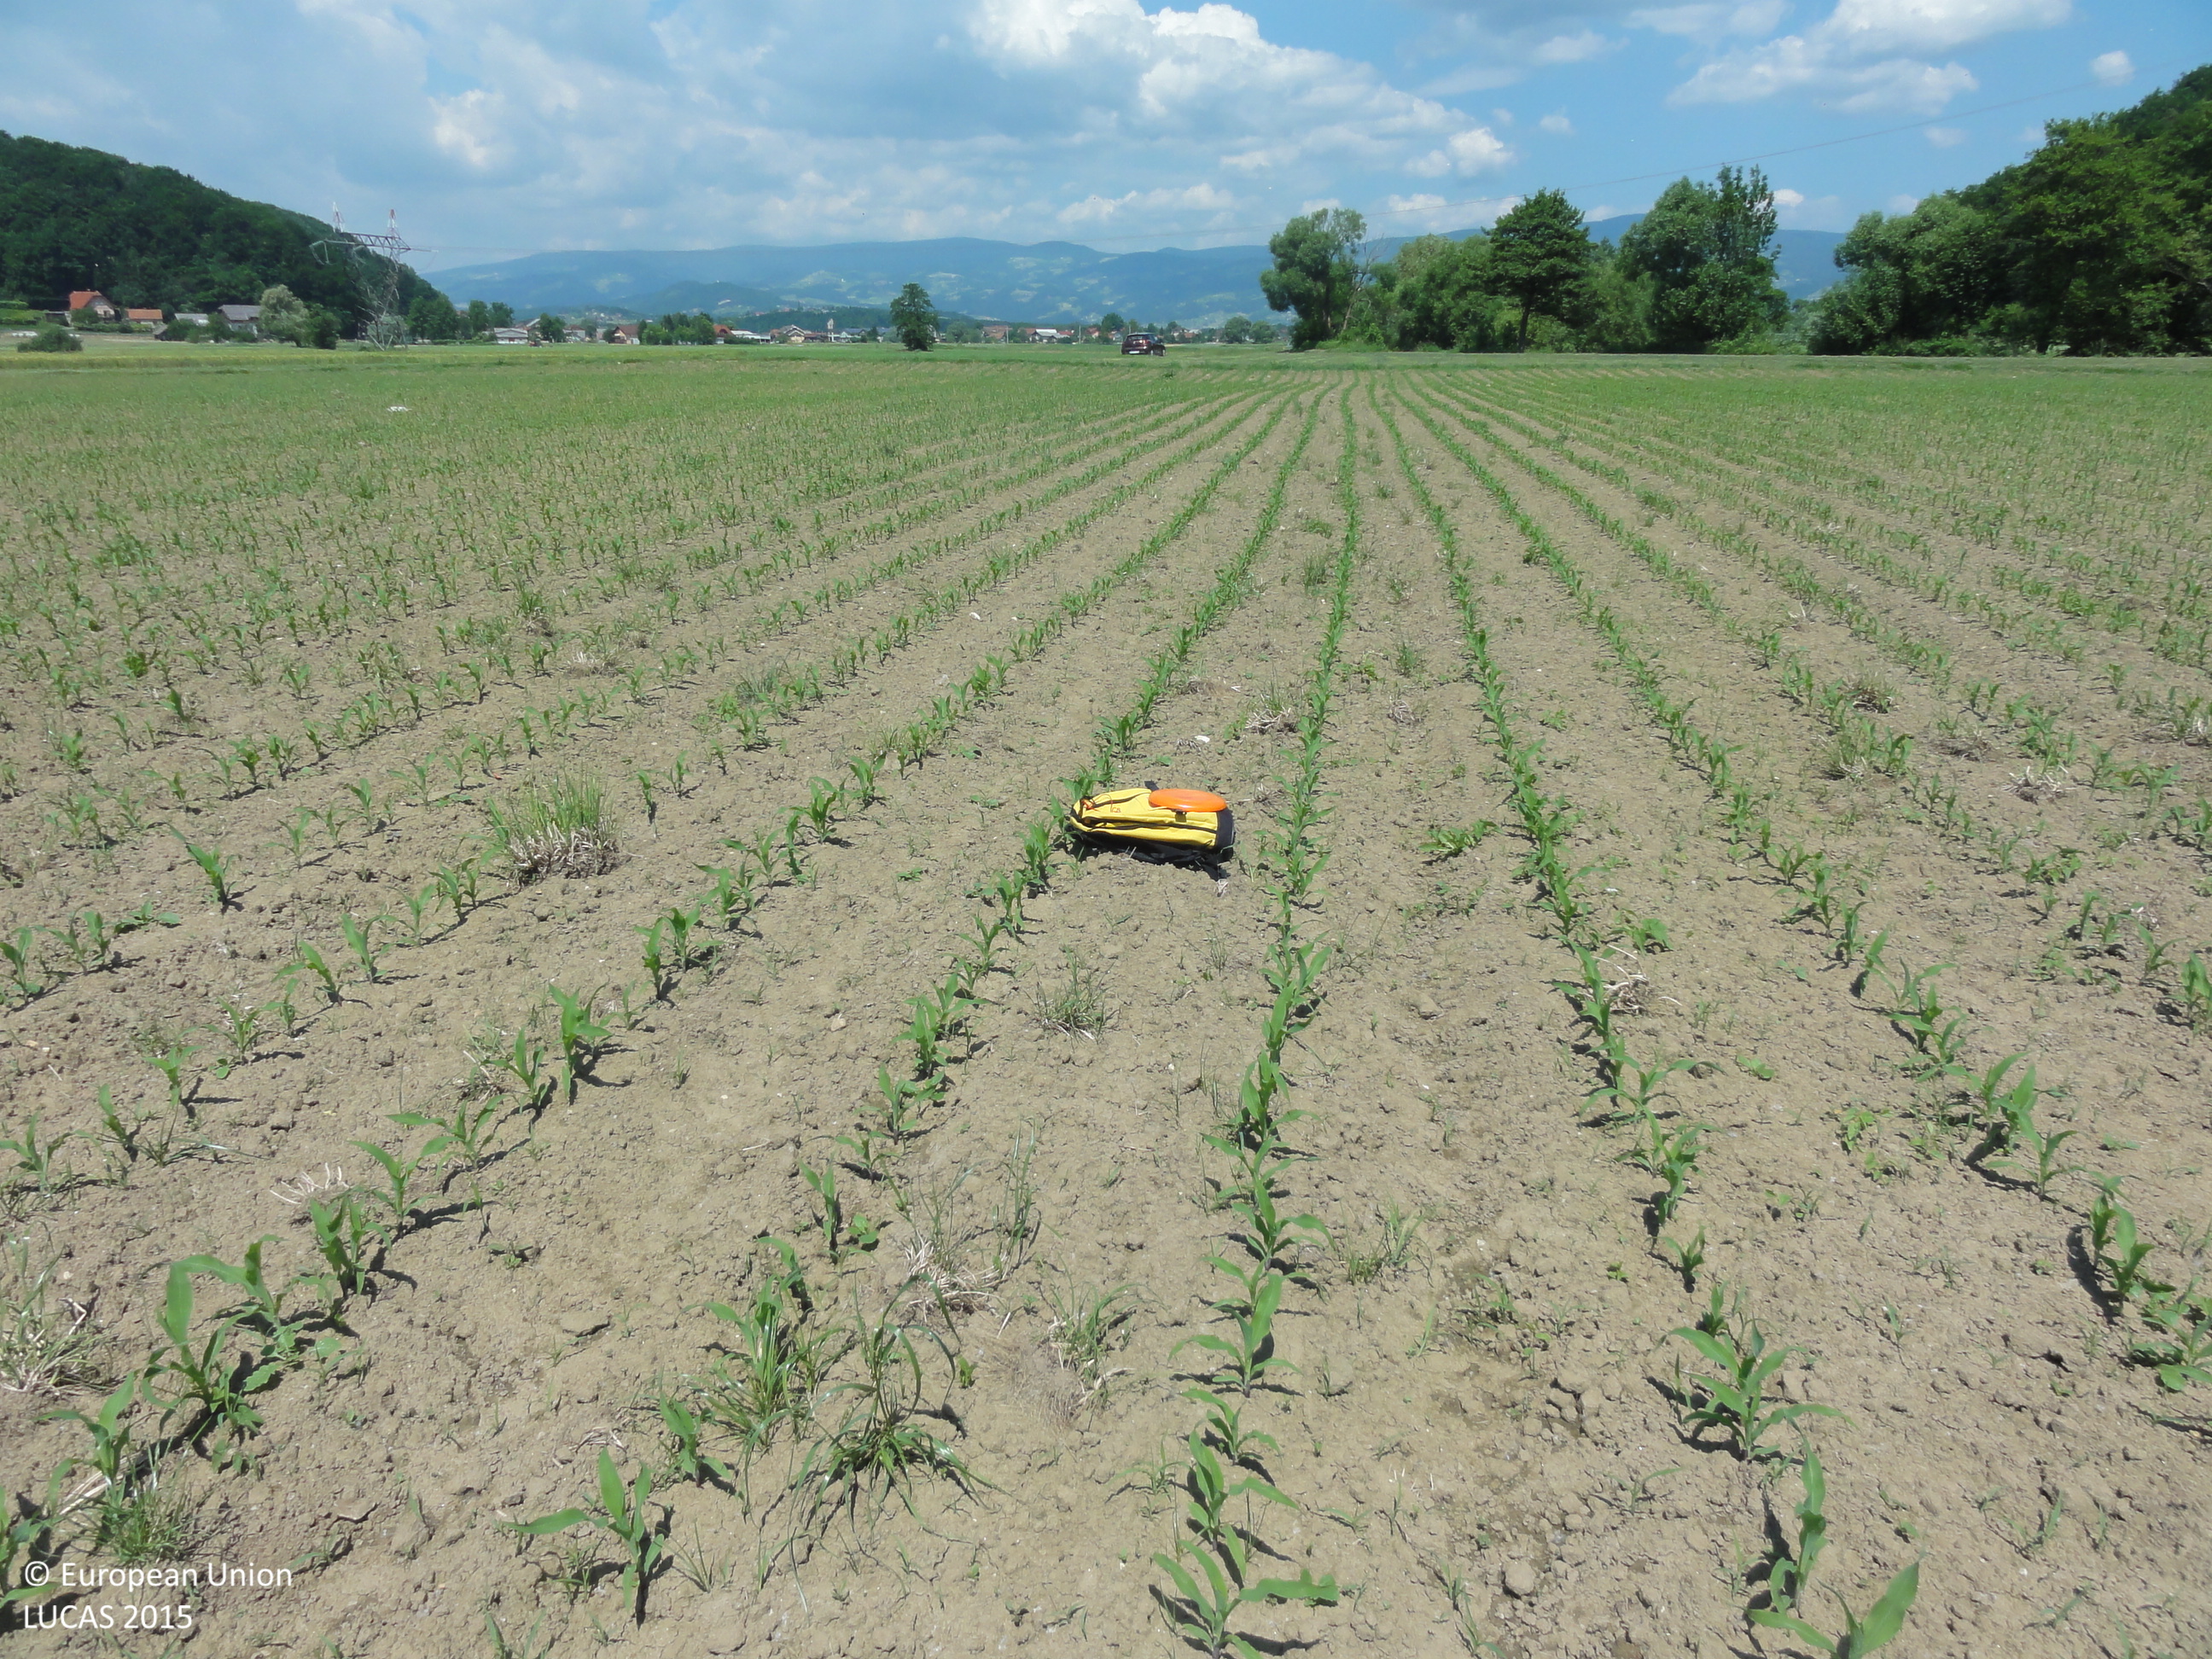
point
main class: Cropland
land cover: Maize
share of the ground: 10 - 25 %
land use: Agriculture (excluding fallow land and kitchen gardens)
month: June
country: SI
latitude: 46.3184
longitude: 15.4918
